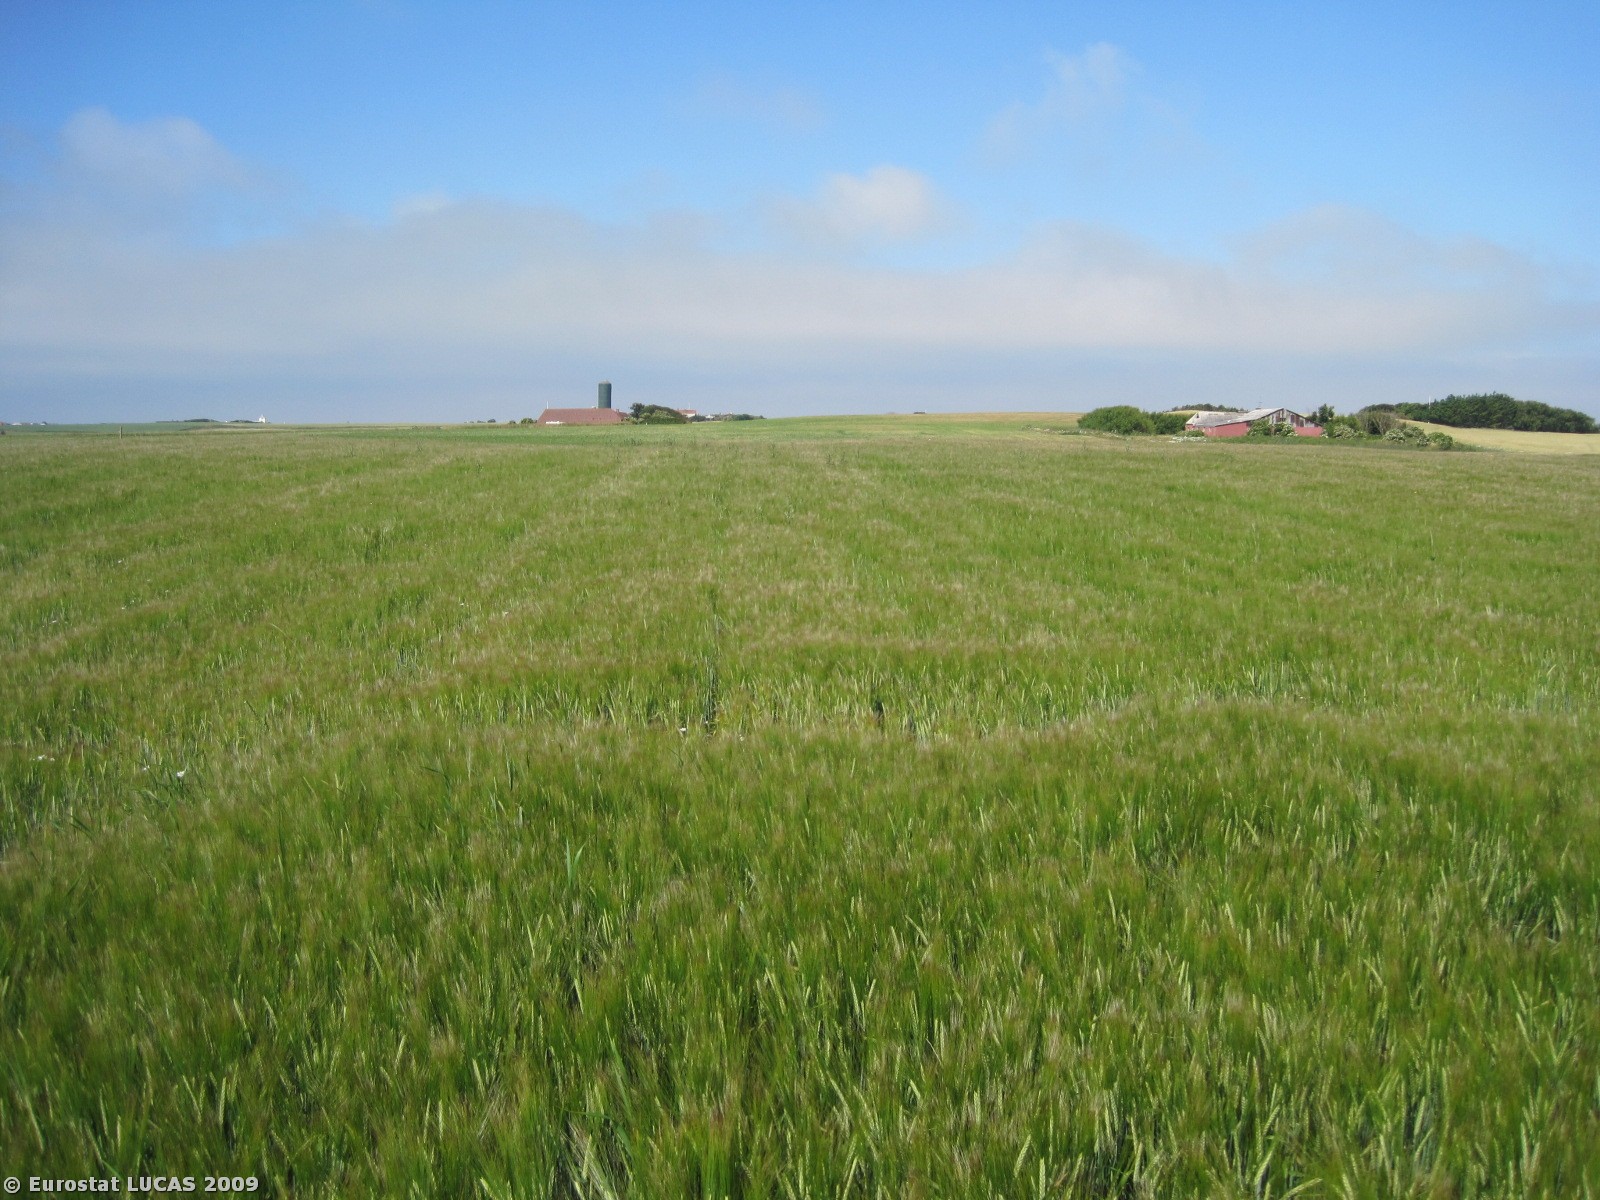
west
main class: Cropland
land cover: Barley
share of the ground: > 75 %
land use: Agriculture (excluding fallow land and kitchen gardens)
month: July
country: DK
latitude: 56.4804
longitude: 8.1674
